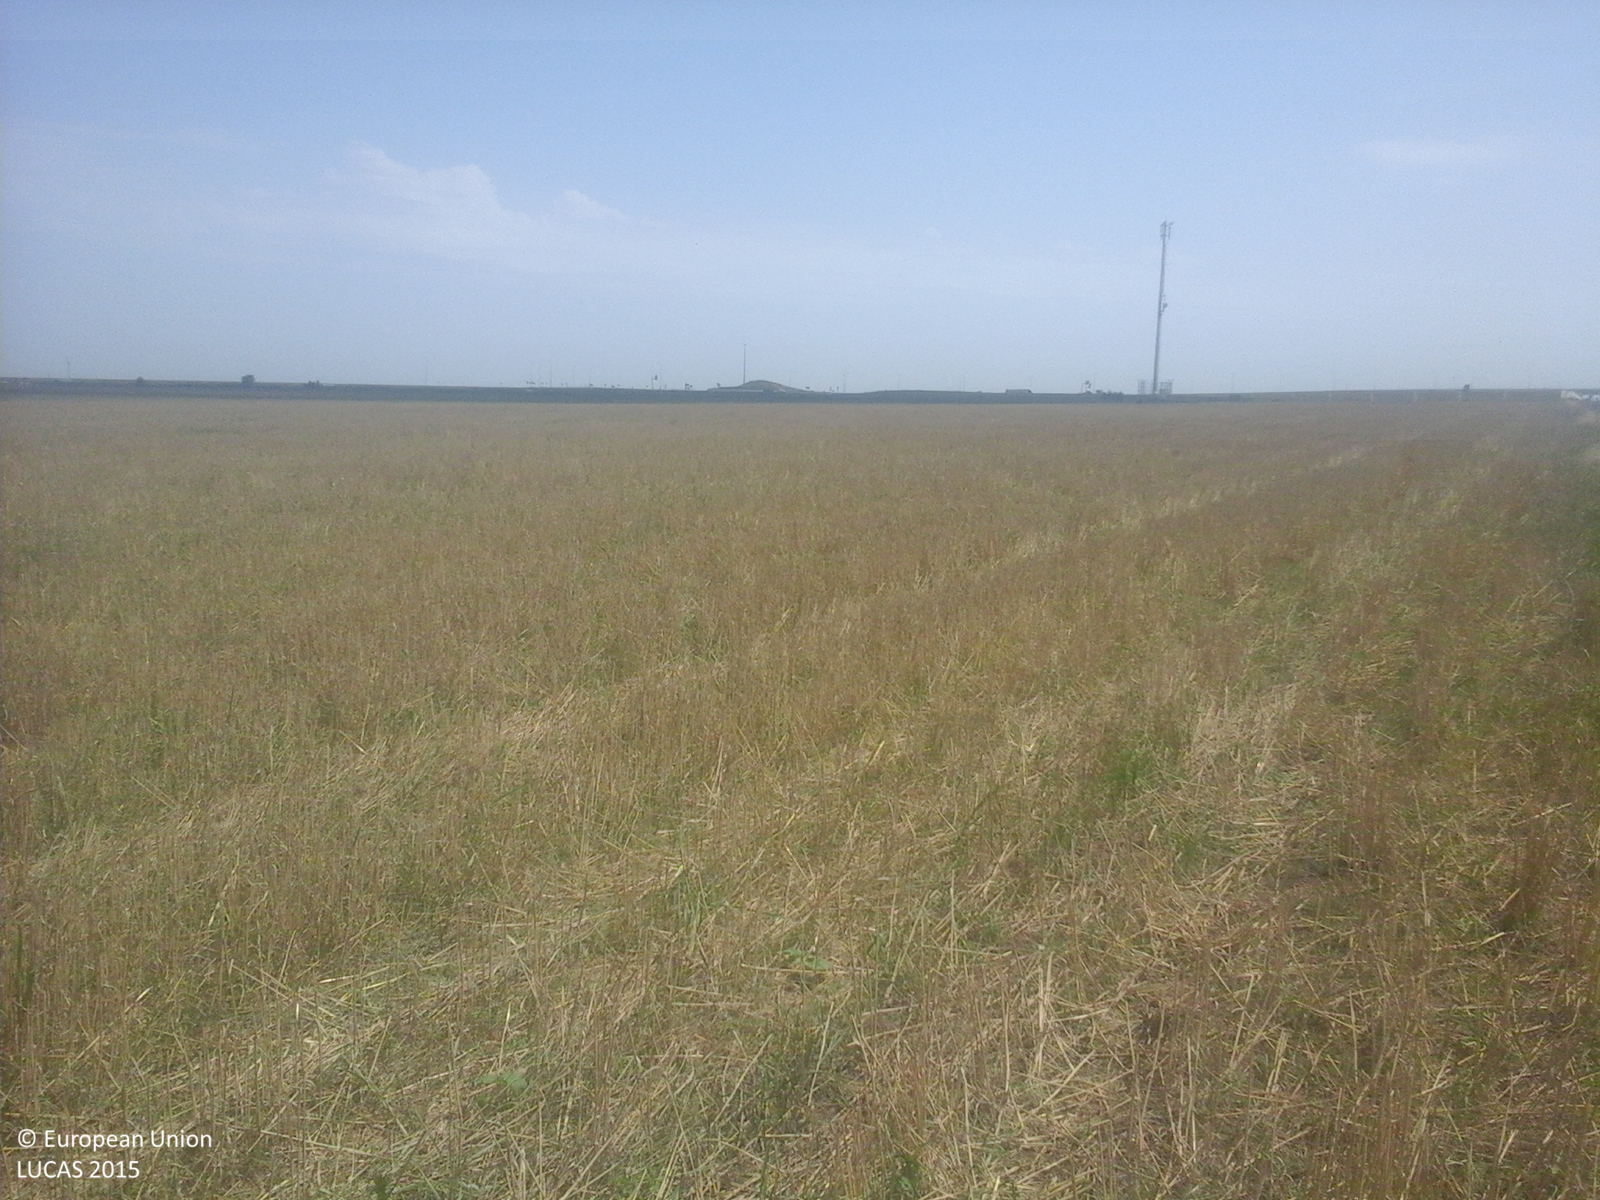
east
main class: Cropland
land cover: Sunflower
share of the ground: > 75 %
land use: Agriculture (excluding fallow land and kitchen gardens)
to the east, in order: Sunflower; Fences; Spontaneously vegetated surfaces; Ditches and canals; Shruby margins; Paved roads, cycling and walking lanes; Shruby margins; Ditches and canals; Spontaneously vegetated surfaces; Fences; Common wheat; Tracks; Common wheat
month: August
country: RO
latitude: 44.1801
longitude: 28.3141
